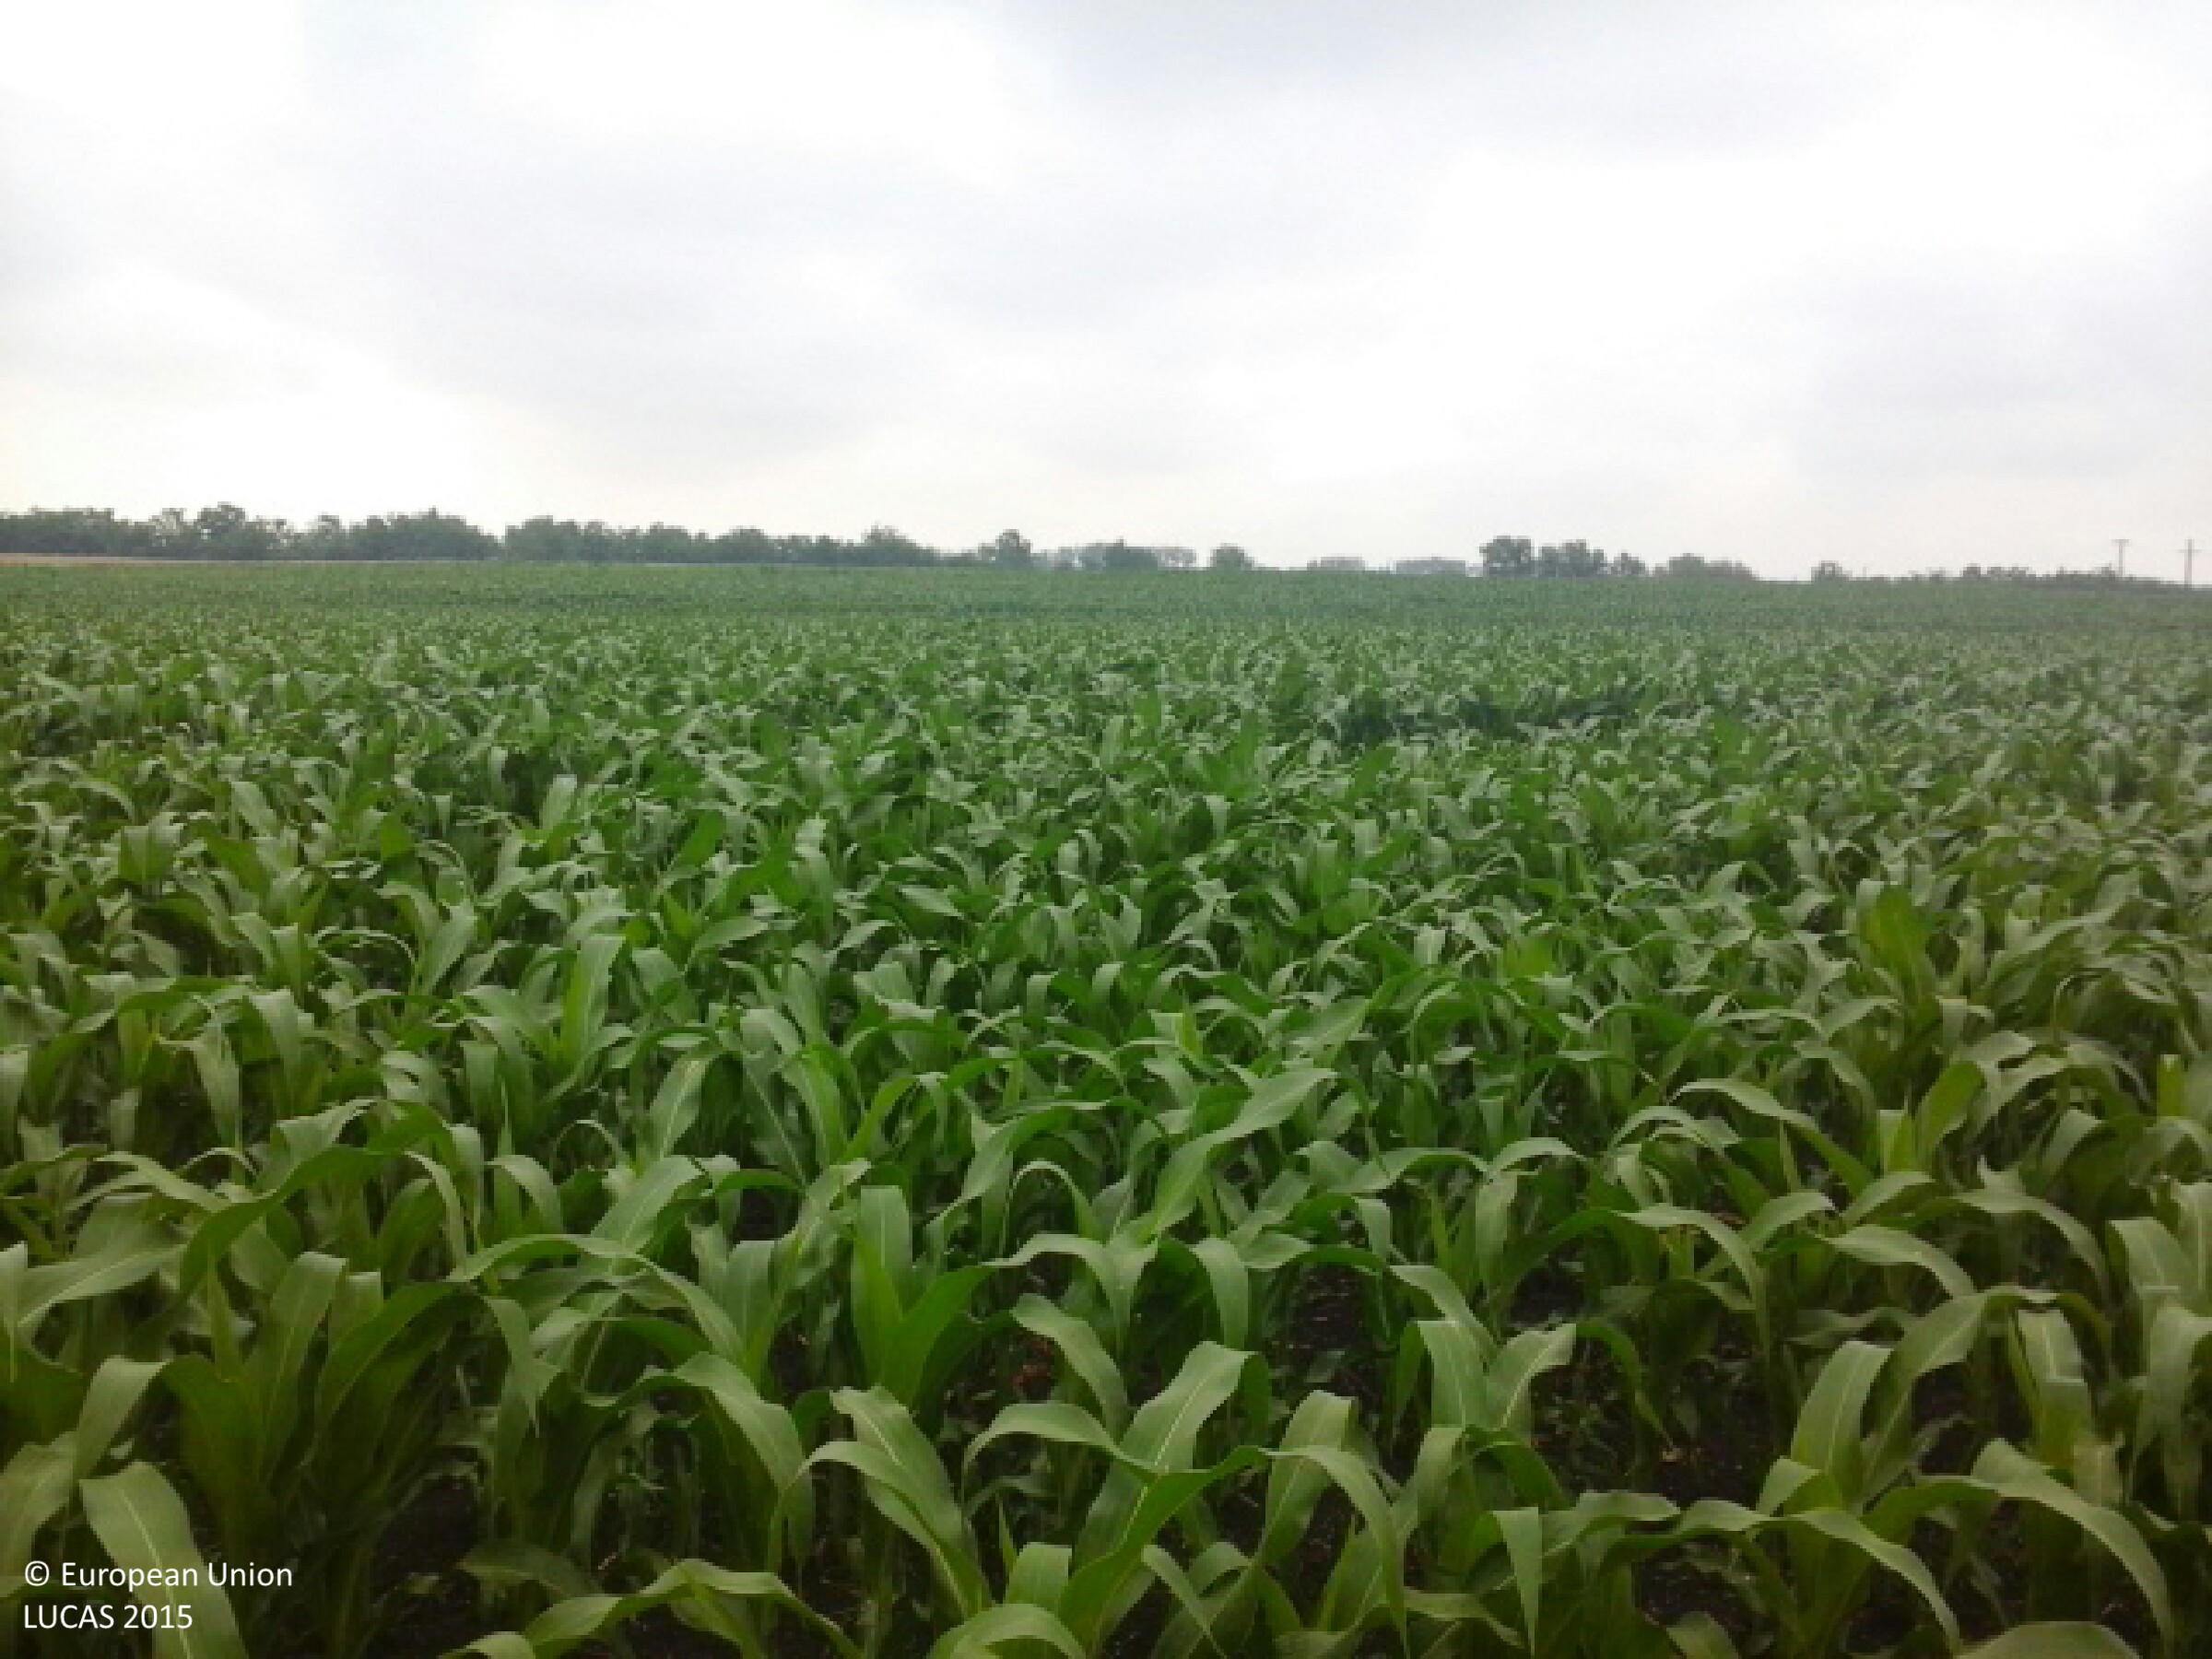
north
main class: Cropland
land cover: Maize
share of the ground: 50 - 75 %
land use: Agriculture (excluding fallow land and kitchen gardens)
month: June
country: HU
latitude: 48.1143
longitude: 21.8029
